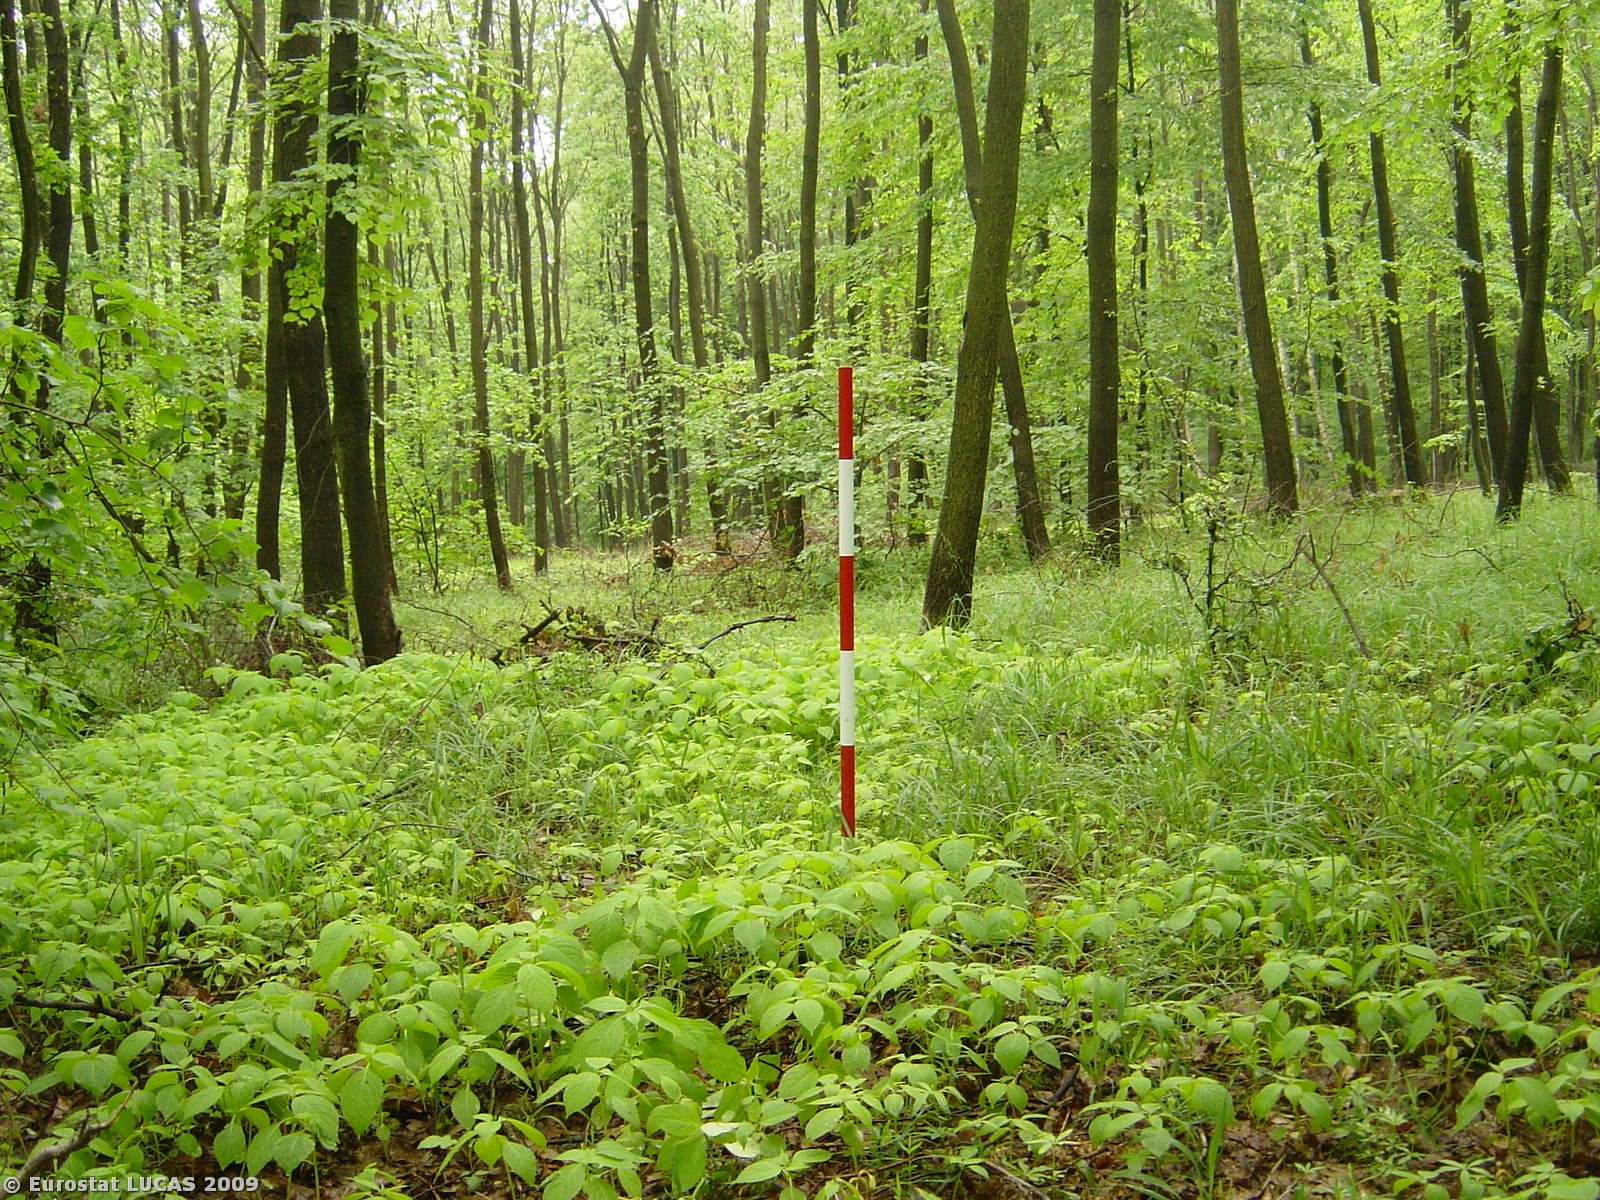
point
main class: Woodland
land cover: Broadleaved woodland
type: mesophytic deciduous forest
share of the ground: > 75 %
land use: Forestry
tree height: > 5 m
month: May
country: CZ
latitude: 49.2238
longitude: 17.0808
